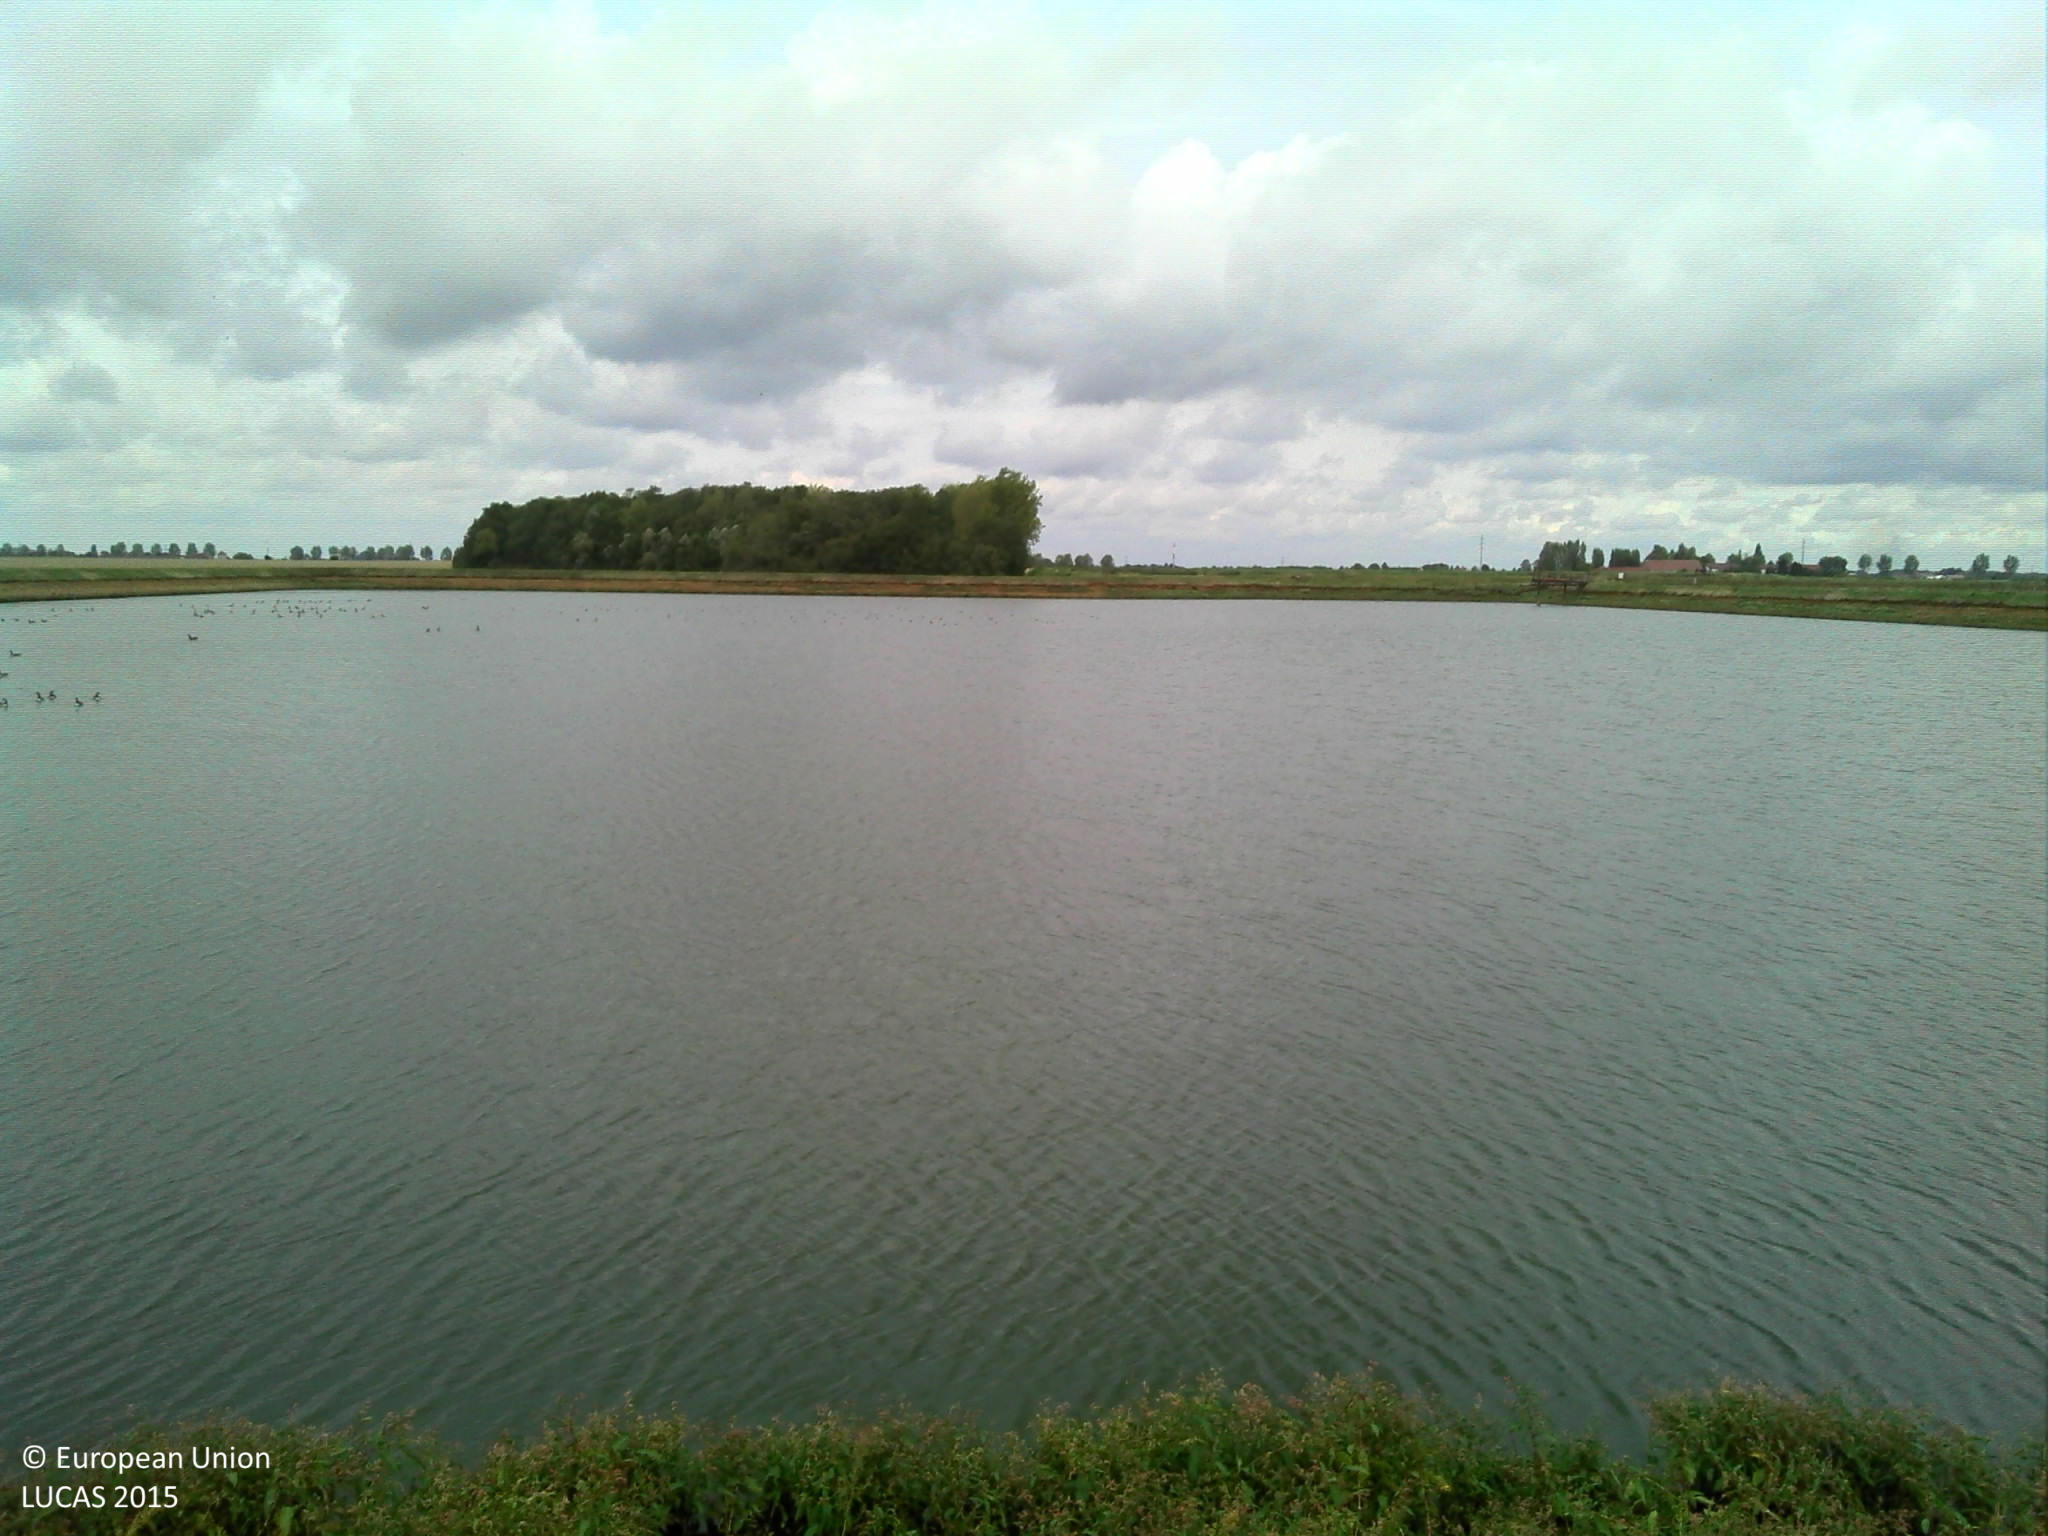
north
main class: Grassland
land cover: Grassland without tree/shrub cover
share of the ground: > 75 %
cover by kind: herbaceous plants 100 %
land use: Waste treatment
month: September
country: FR
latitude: 48.5599
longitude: 2.9865
